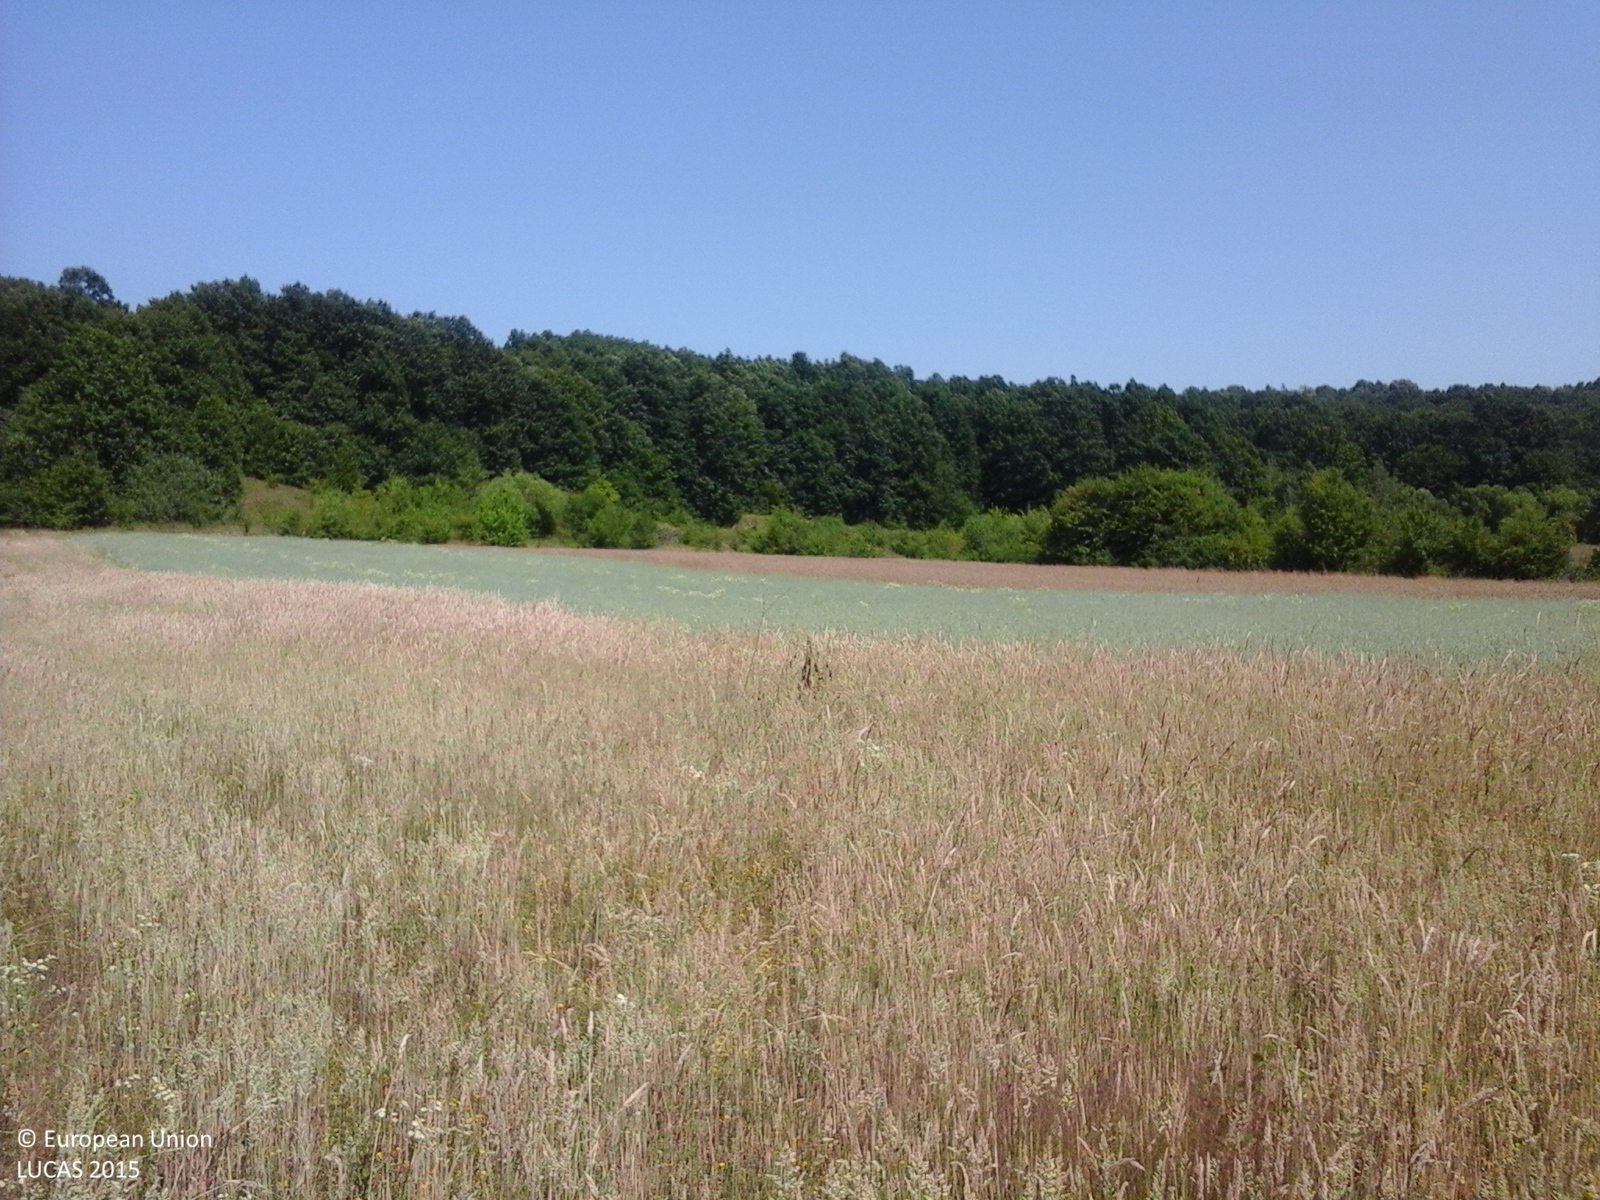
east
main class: Grassland
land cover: Grassland without tree/shrub cover
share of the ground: > 75 %
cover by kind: herbaceous plants 100 %
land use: Agriculture (excluding fallow land and kitchen gardens)
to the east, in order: Grassland without tree/shrub cover; Oats; Common wheat; Grassland with sparse tree/shrub cover; Broadleaved woodland
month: July
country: RO
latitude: 44.8821
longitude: 24.6231
